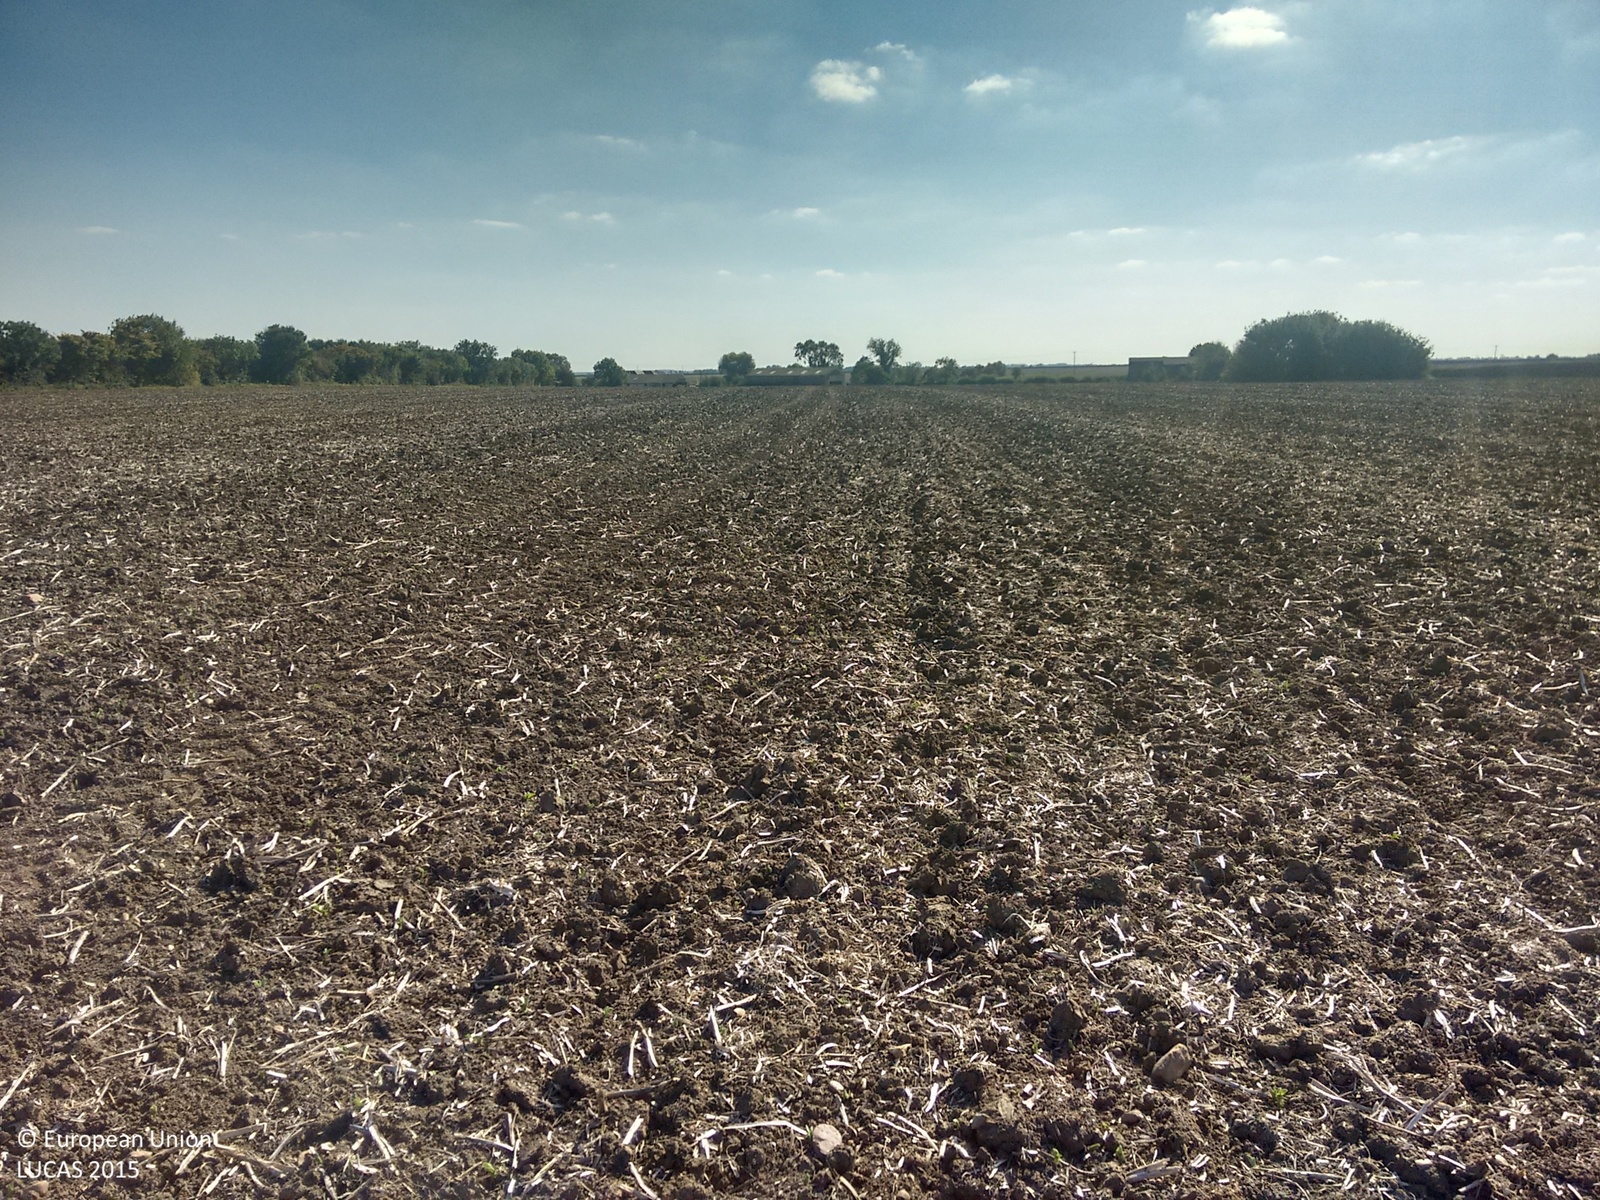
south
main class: Cropland
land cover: Rape and turnip rape
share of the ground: 10 - 25 %
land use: Agriculture (excluding fallow land and kitchen gardens)
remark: Harvested field
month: September
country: GB
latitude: 52.3937
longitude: -0.3674
